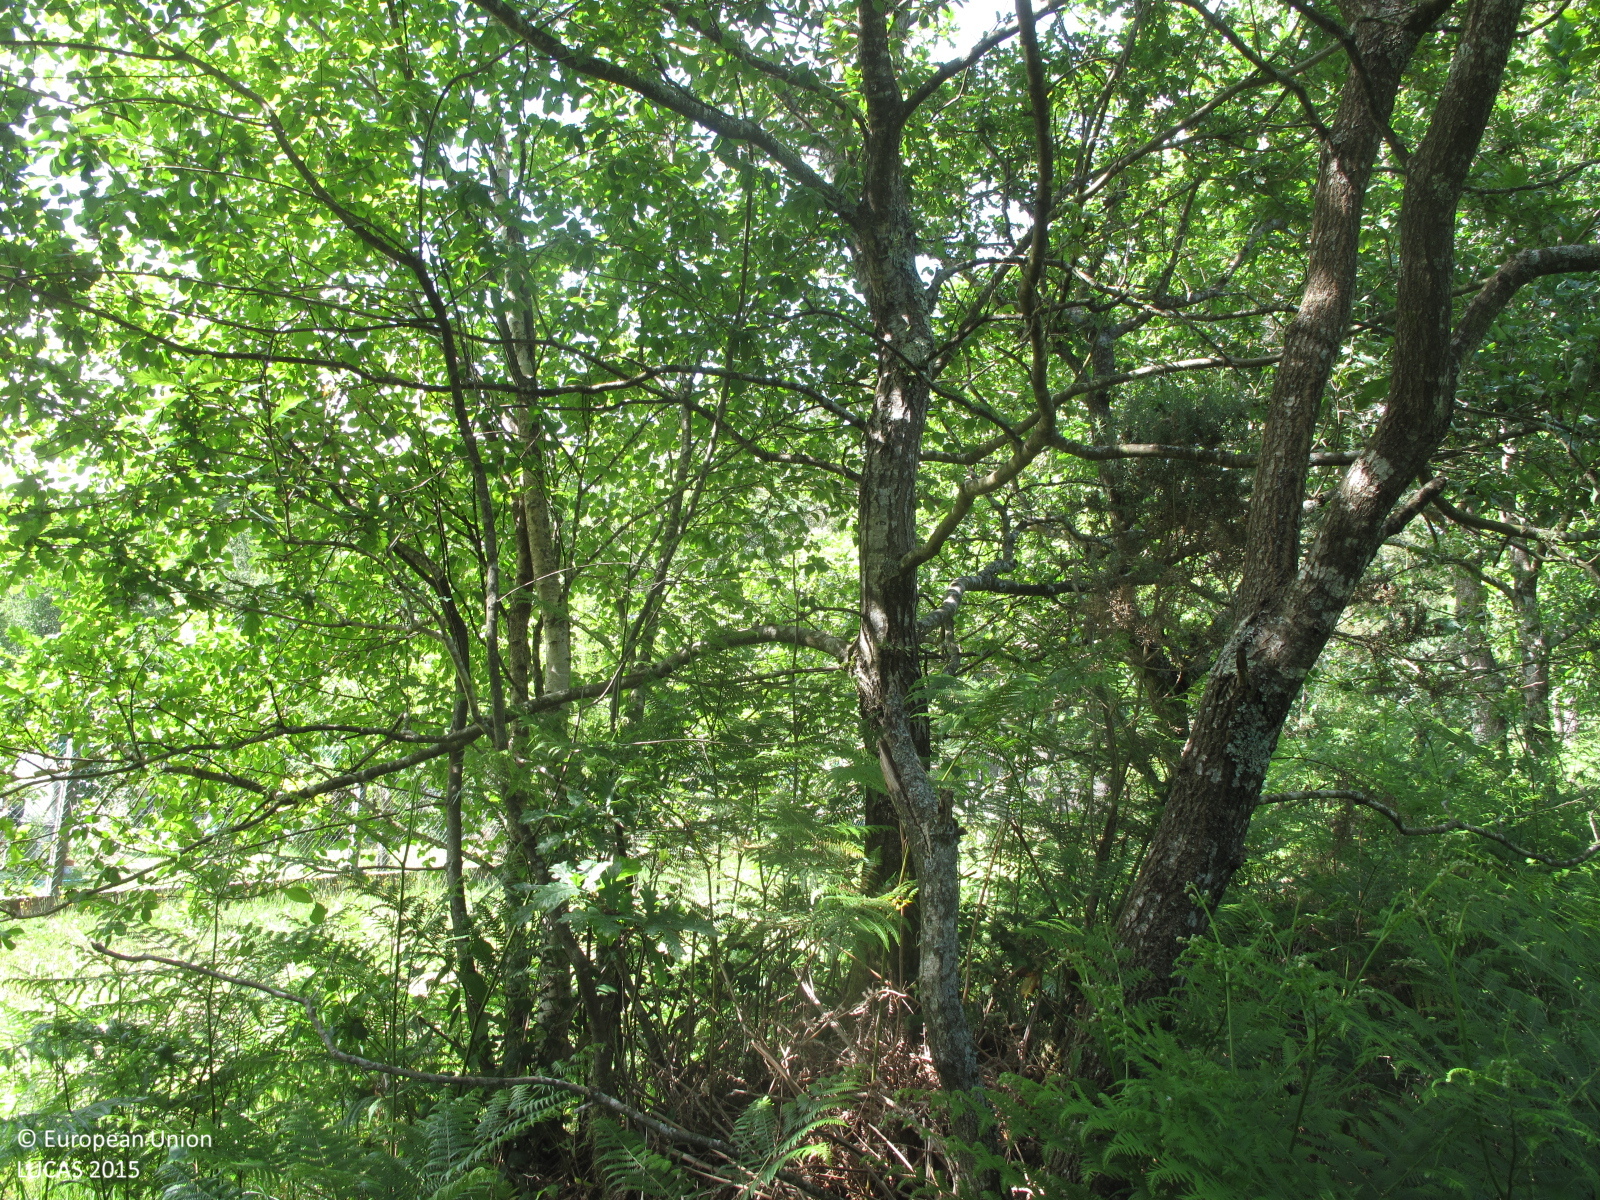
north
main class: Woodland
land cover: Broadleaved woodland
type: acidophilous oak and oak-birch forest
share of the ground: 25 - 50 %
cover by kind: herbaceous plants 60 %, broadleaved forest trees 30 %, shrubs 10 %
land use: Forestry
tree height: > 5 m
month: June
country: ES
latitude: 42.9504
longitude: -8.4767
